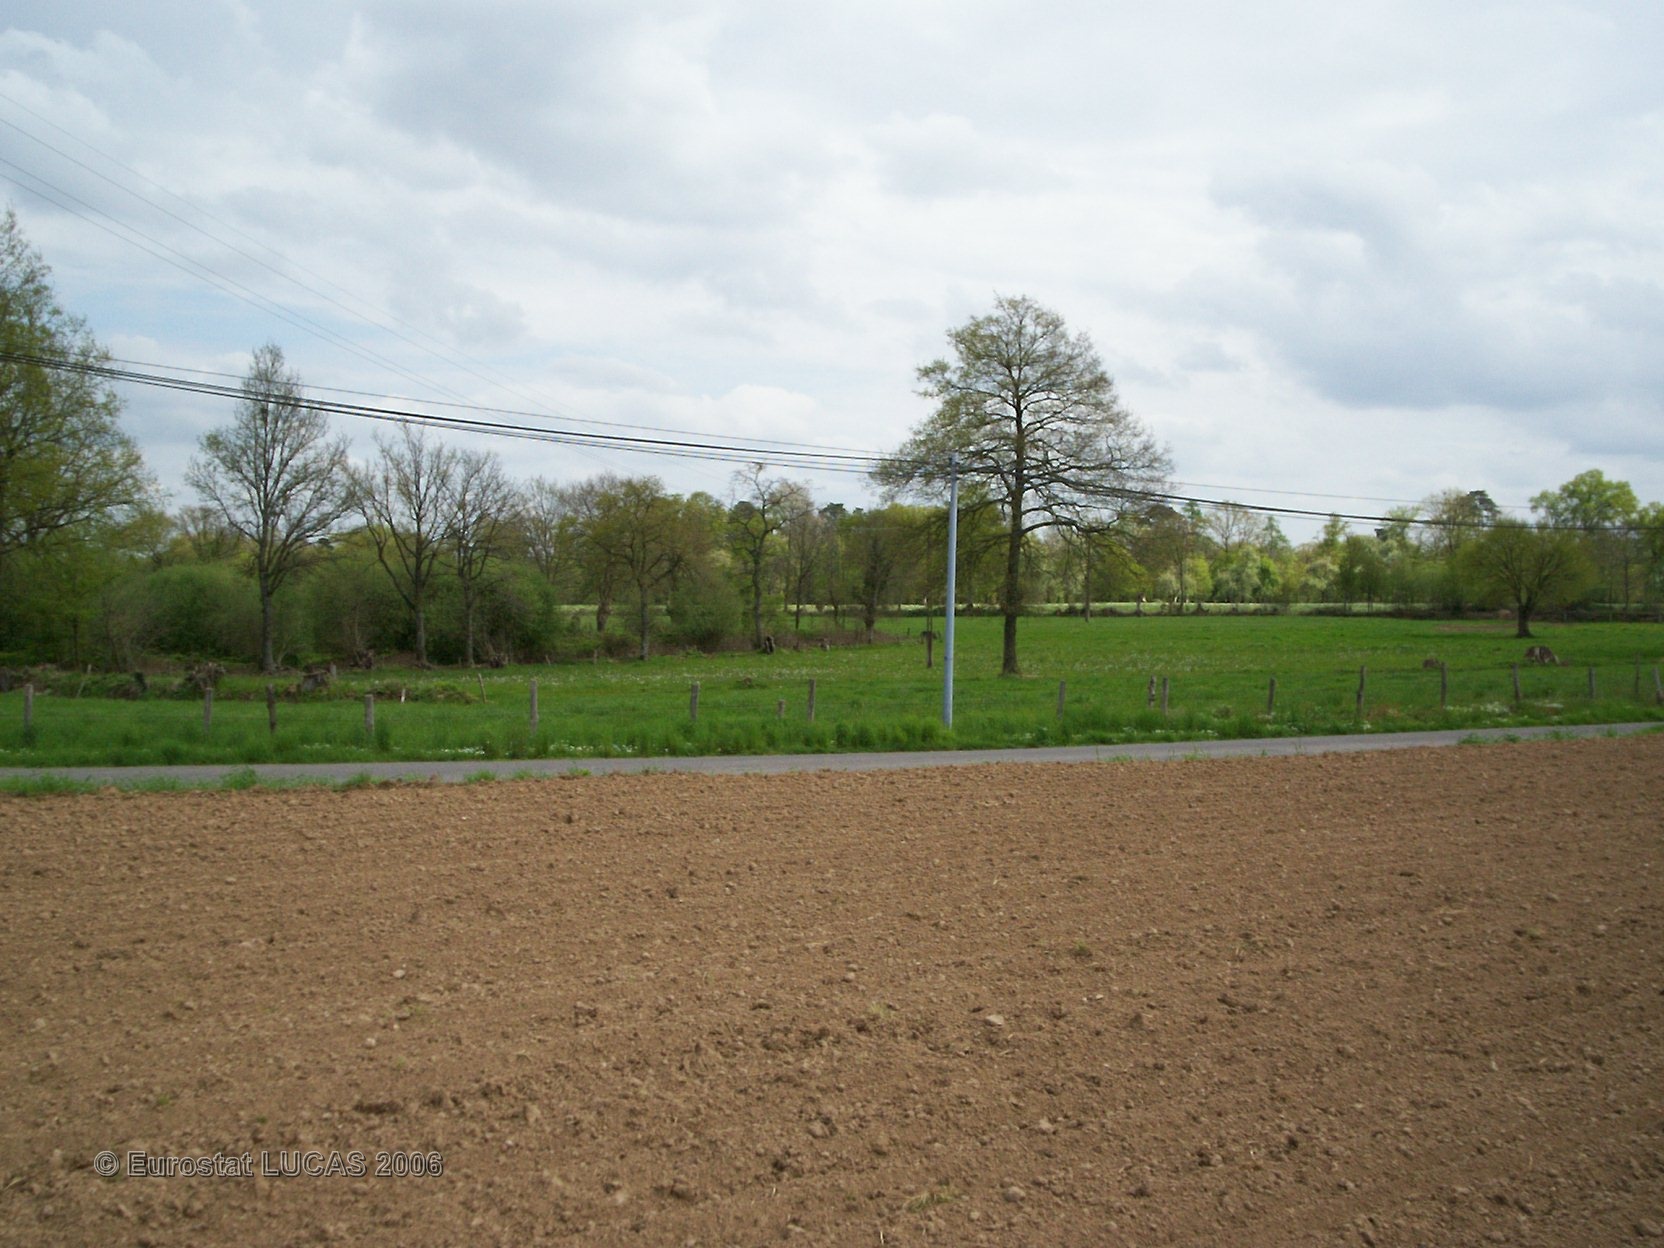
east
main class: Cropland
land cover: Maize
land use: Agriculture (excluding fallow land and kitchen gardens)
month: May
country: FR
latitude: 48.5694
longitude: -0.7303
